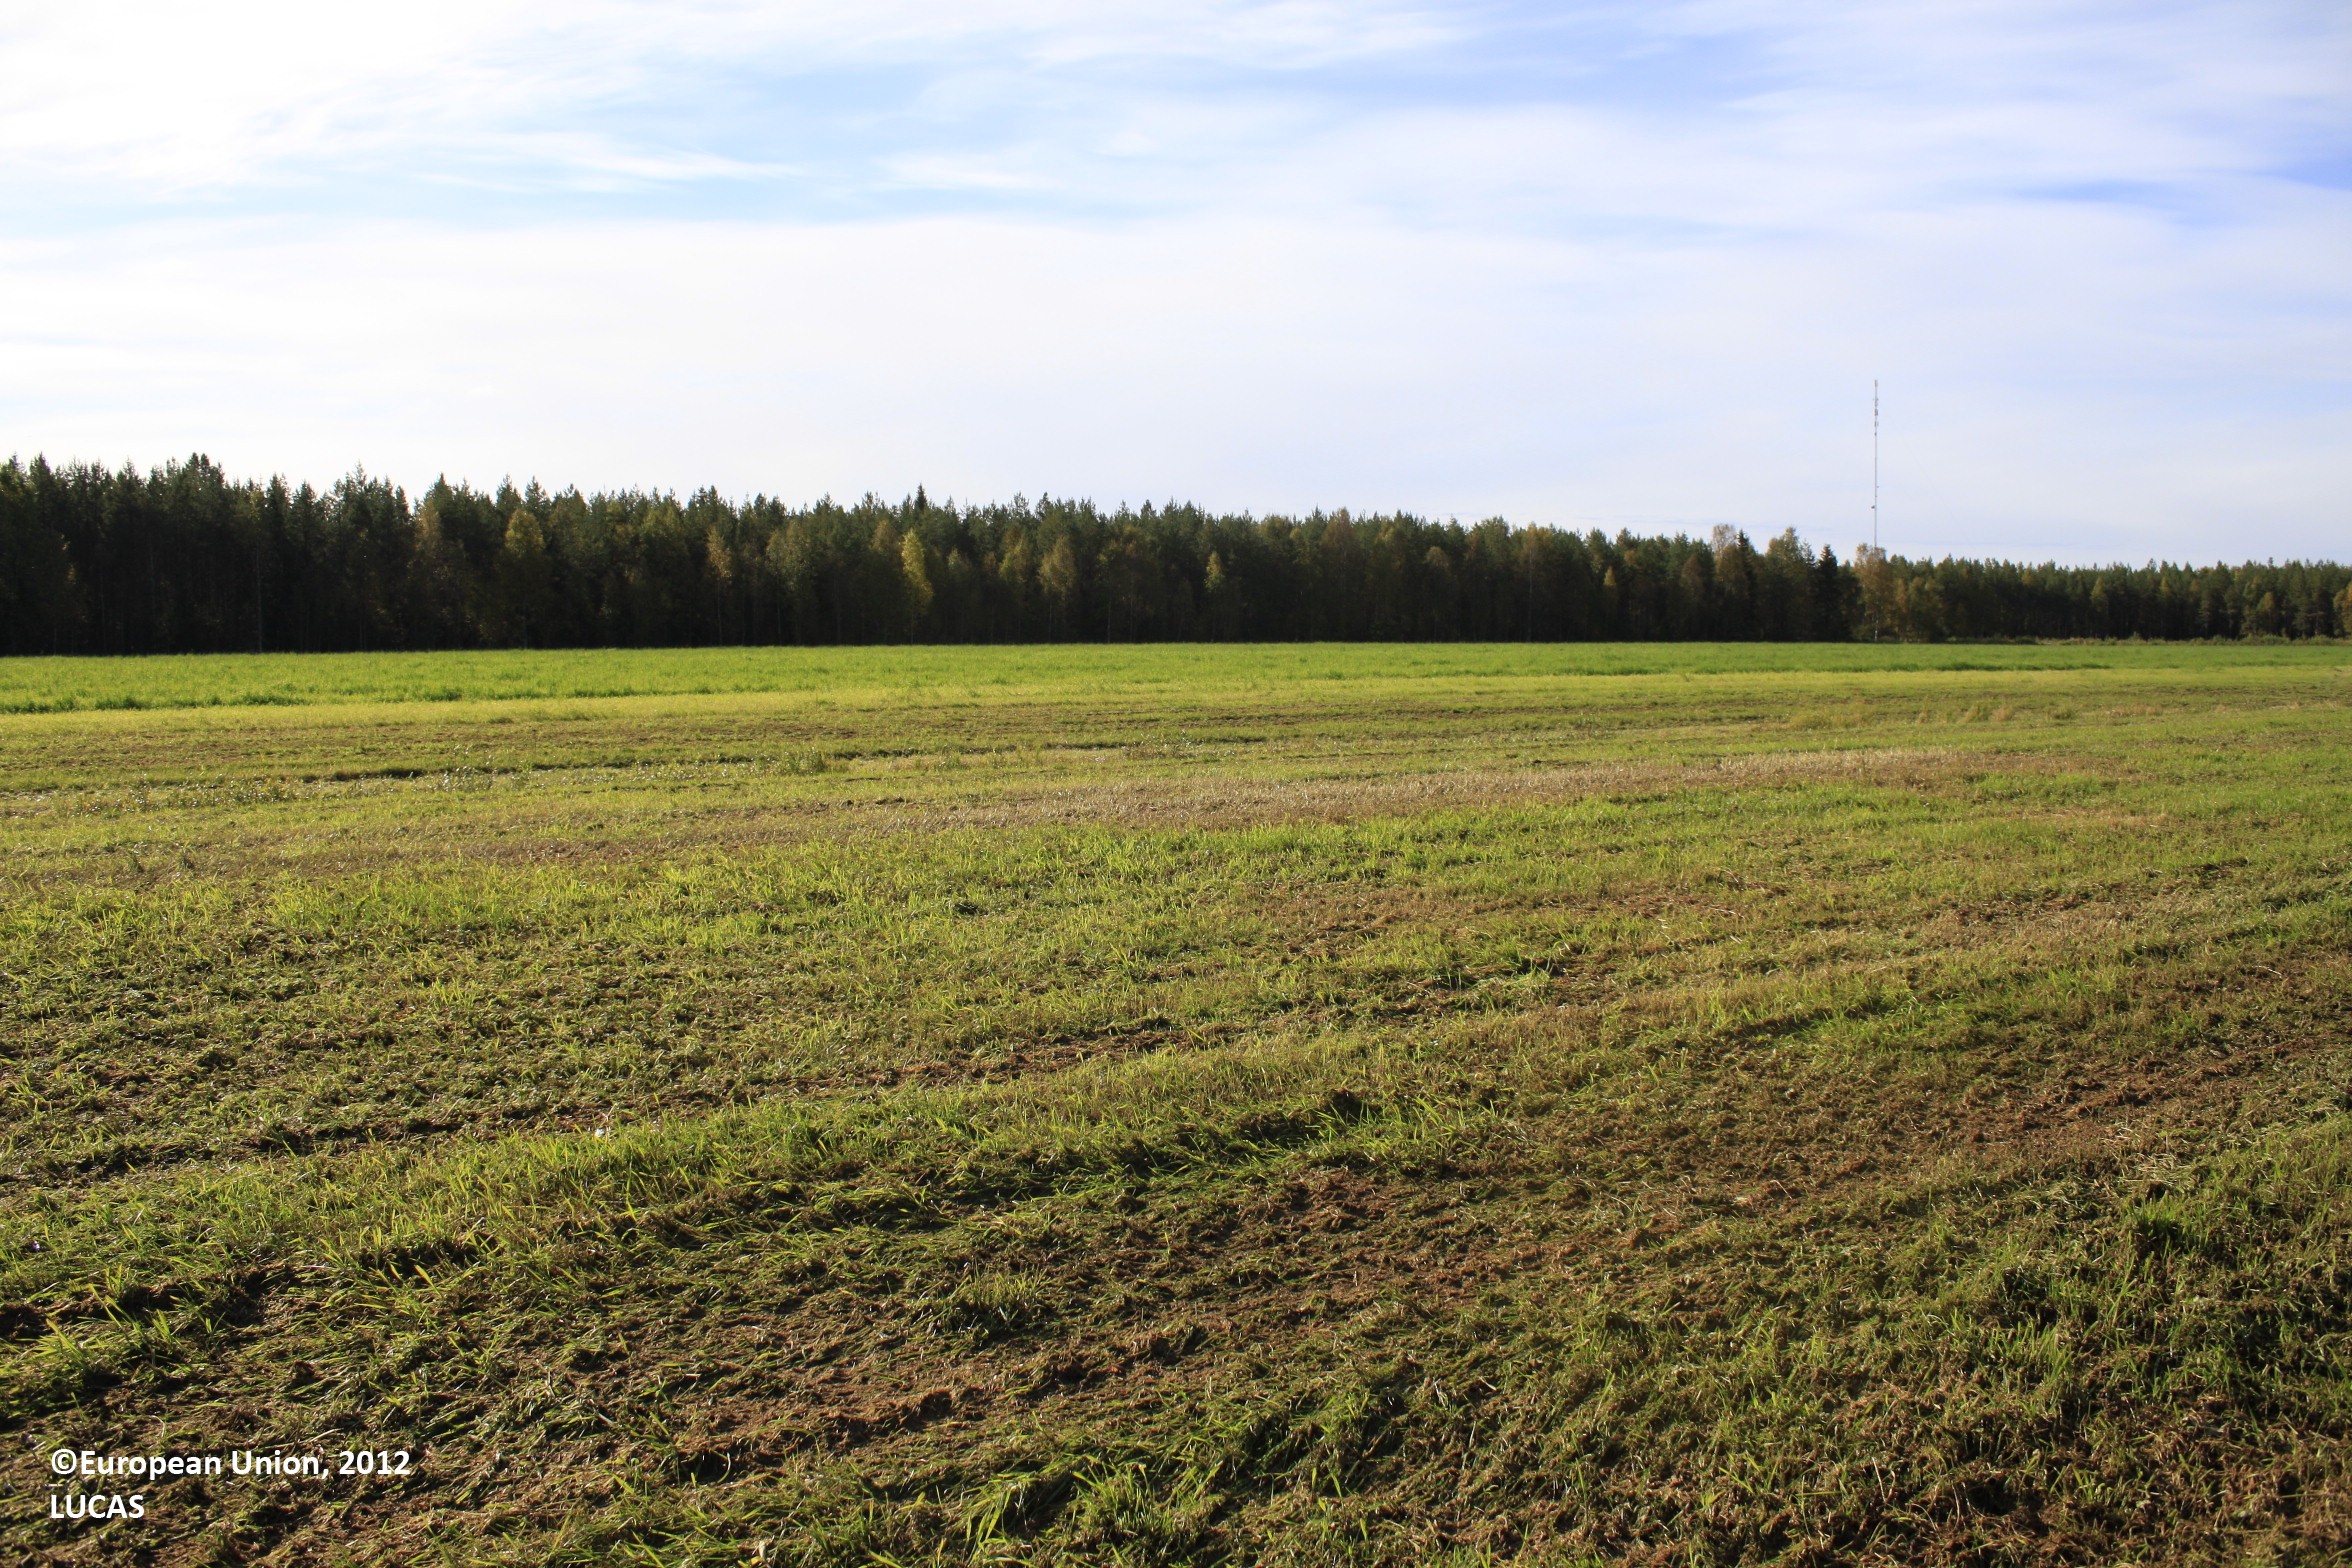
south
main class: Grassland
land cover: Grassland without tree/shrub cover
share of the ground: > 75 %
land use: Agriculture (excluding fallow land and kitchen gardens)
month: September
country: FI
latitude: 65.5888
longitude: 27.1848
